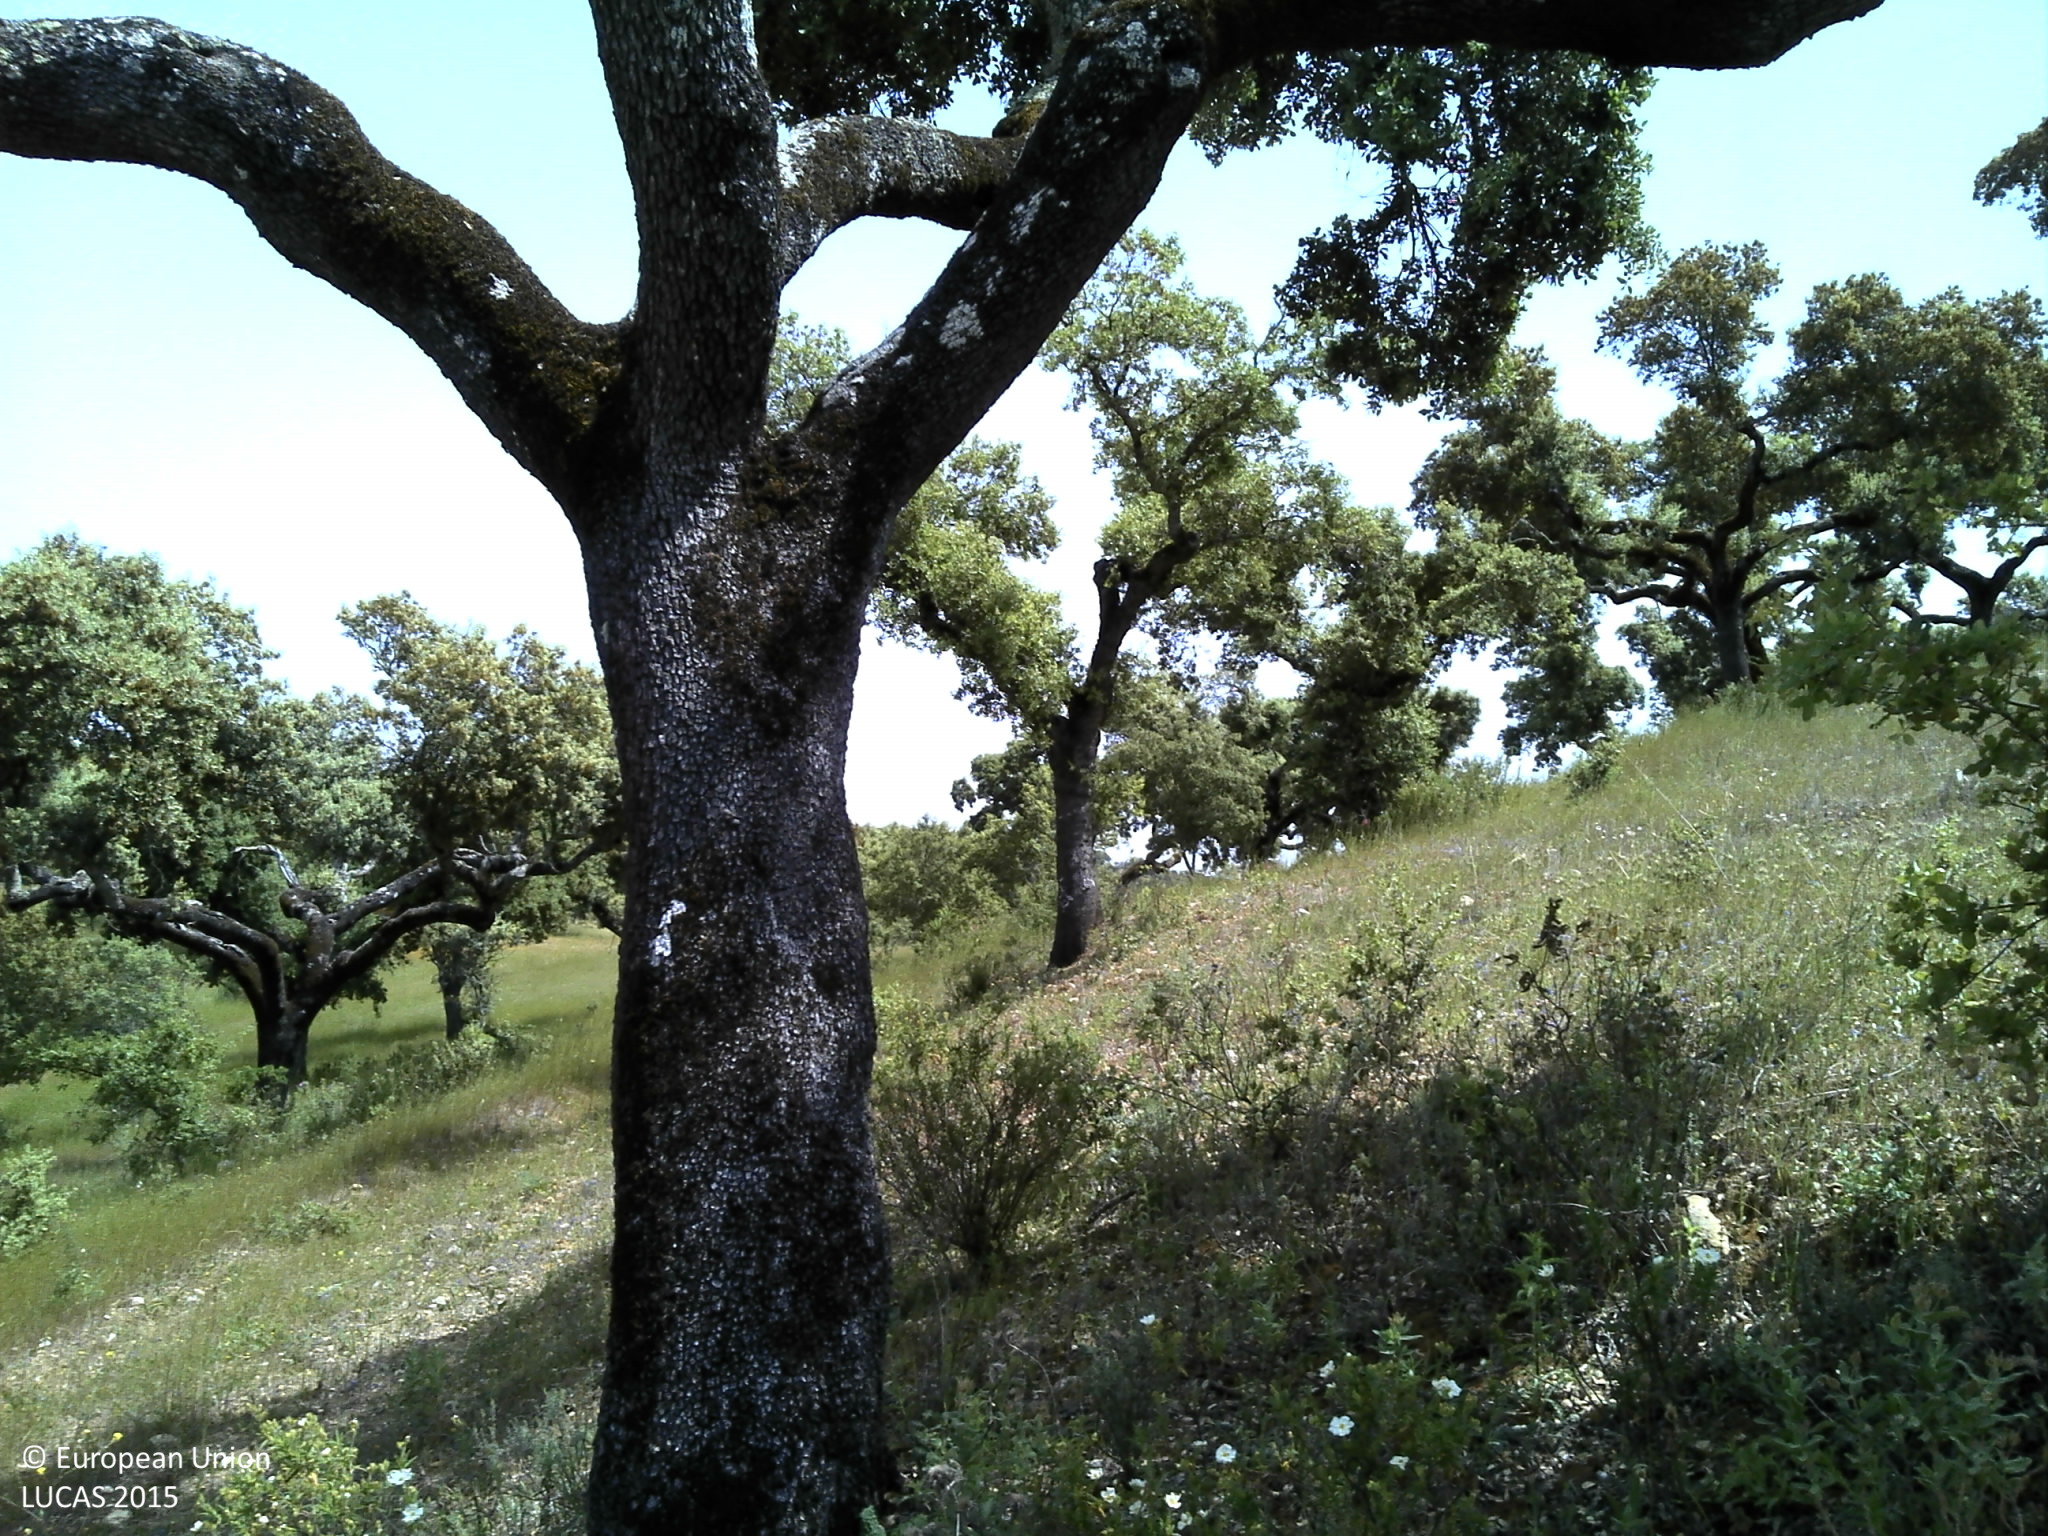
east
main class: Woodland
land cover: Broadleaved woodland
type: broadleaved evergreen forest
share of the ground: 50 - 75 %
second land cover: Grassland without tree/shrub cover
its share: 10 - 25 %
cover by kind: broadleaved forest trees 60 %, herbaceous plants 25 %, unconsolidated bare surface 15 %
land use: Forestry
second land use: Agriculture (excluding fallow land and kitchen gardens)
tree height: > 5 m
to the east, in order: Broadleaved woodland; Grassland without tree/shrub cover; Broadleaved woodland; Grassland without tree/shrub cover; Broadleaved woodland; Tracks; Broadleaved woodland
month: May
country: PT
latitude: 39.0142
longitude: -7.8907
